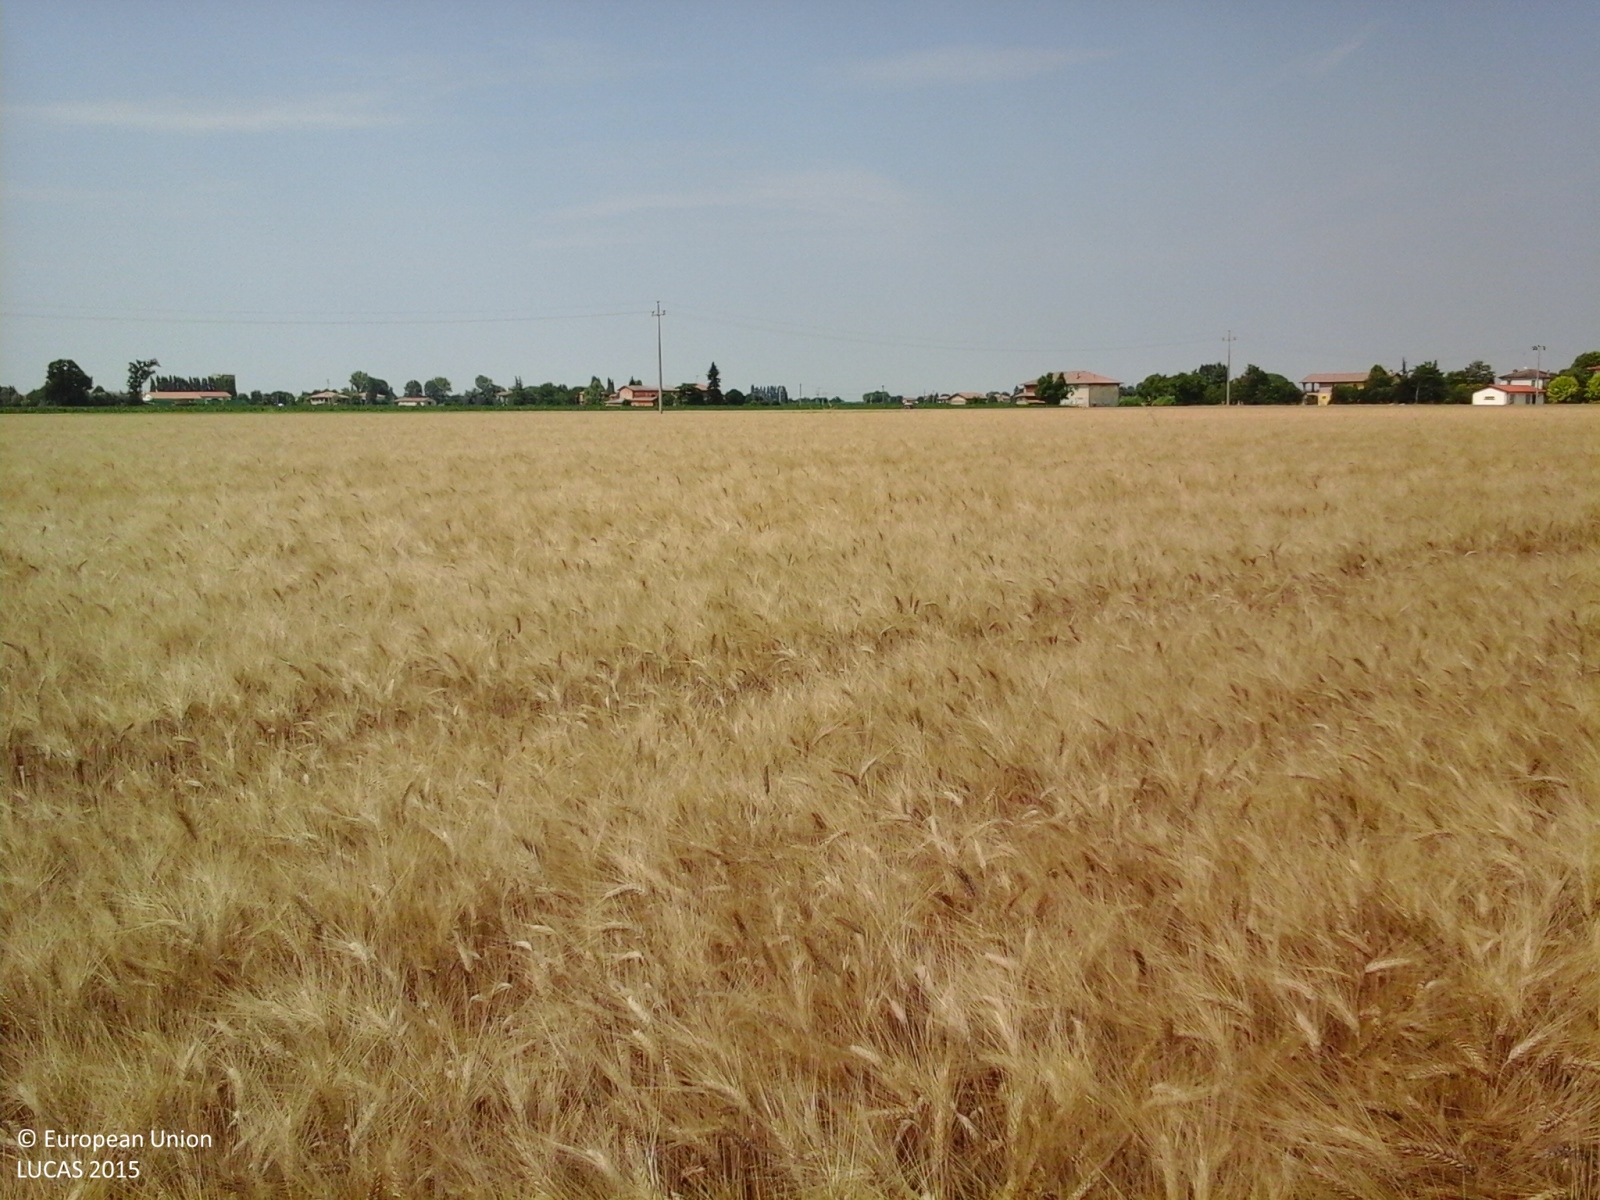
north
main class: Cropland
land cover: Common wheat
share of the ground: > 75 %
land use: Agriculture (excluding fallow land and kitchen gardens)
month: June
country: IT
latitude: 44.5908
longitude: 11.5964
